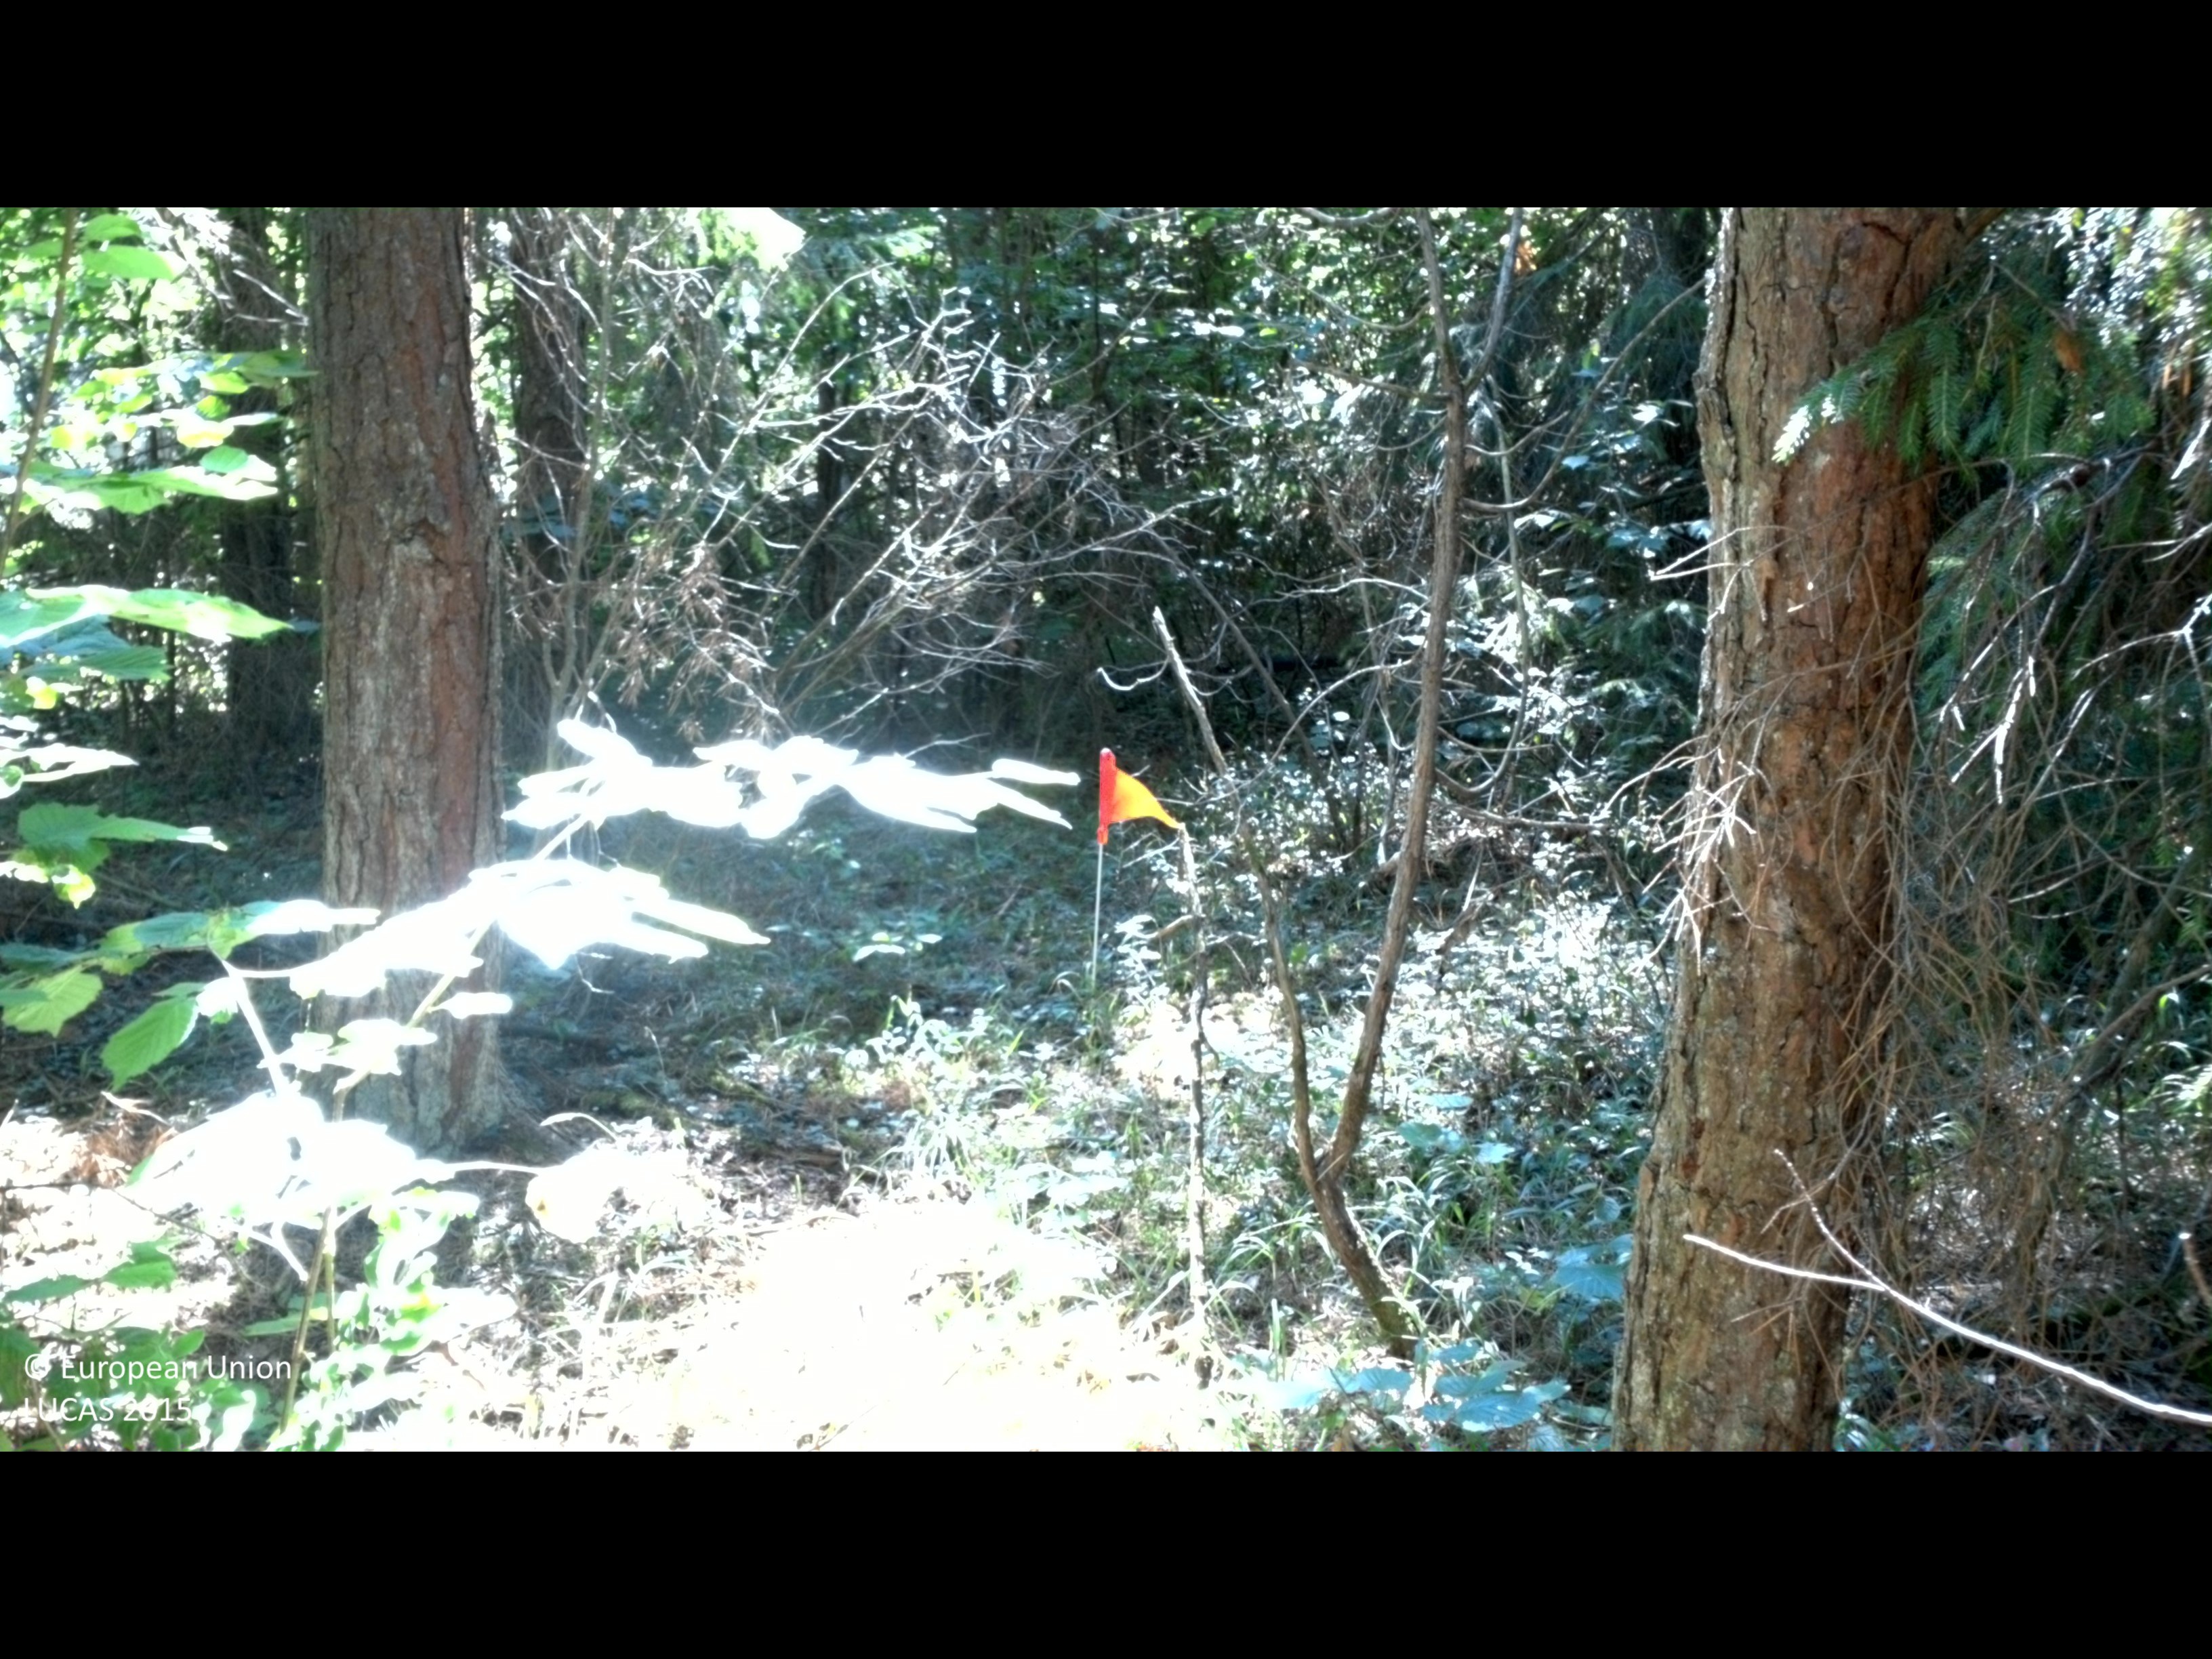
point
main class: Woodland
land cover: Pine dominated coniferous woodland
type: boreal forest
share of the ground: 50 - 75 %
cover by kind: coniferous forest trees 65 %, shrubs 30 %, herbaceous plants 5 %
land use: Forestry
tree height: > 5 m
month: July
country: SE
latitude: 56.5954
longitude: 16.5978
